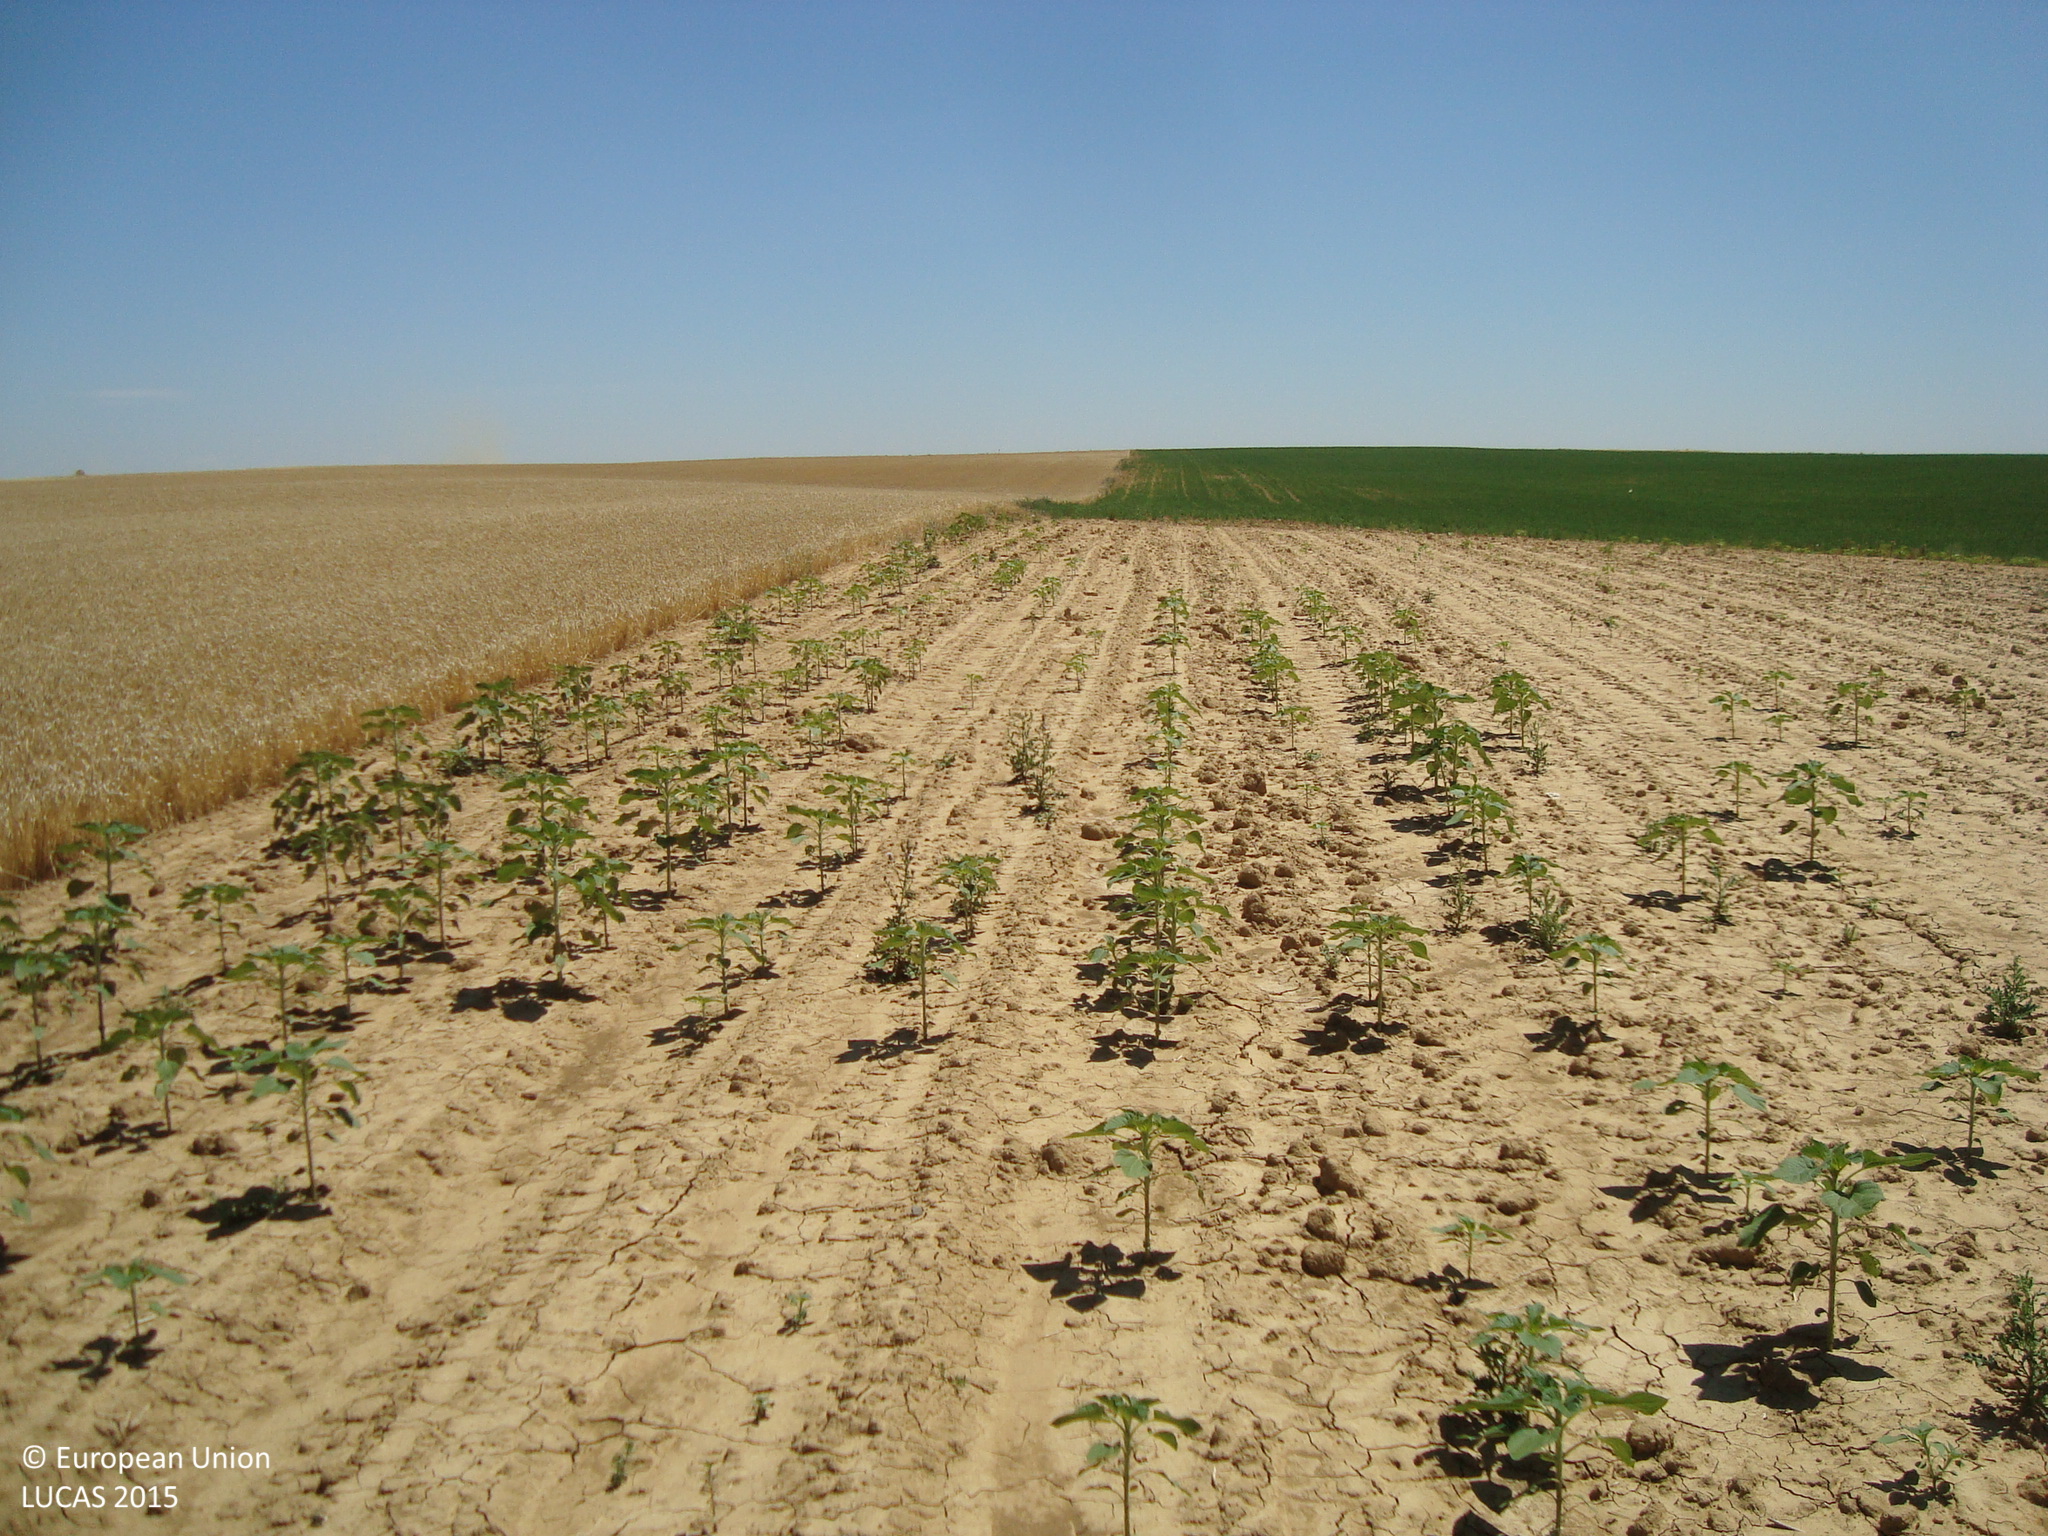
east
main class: Cropland
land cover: Sunflower
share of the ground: 25 - 50 %
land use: Agriculture (excluding fallow land and kitchen gardens)
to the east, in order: Sunflower; Lucerne; Grass margins; Barley
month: July
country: ES
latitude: 42.1424
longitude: -4.8267
